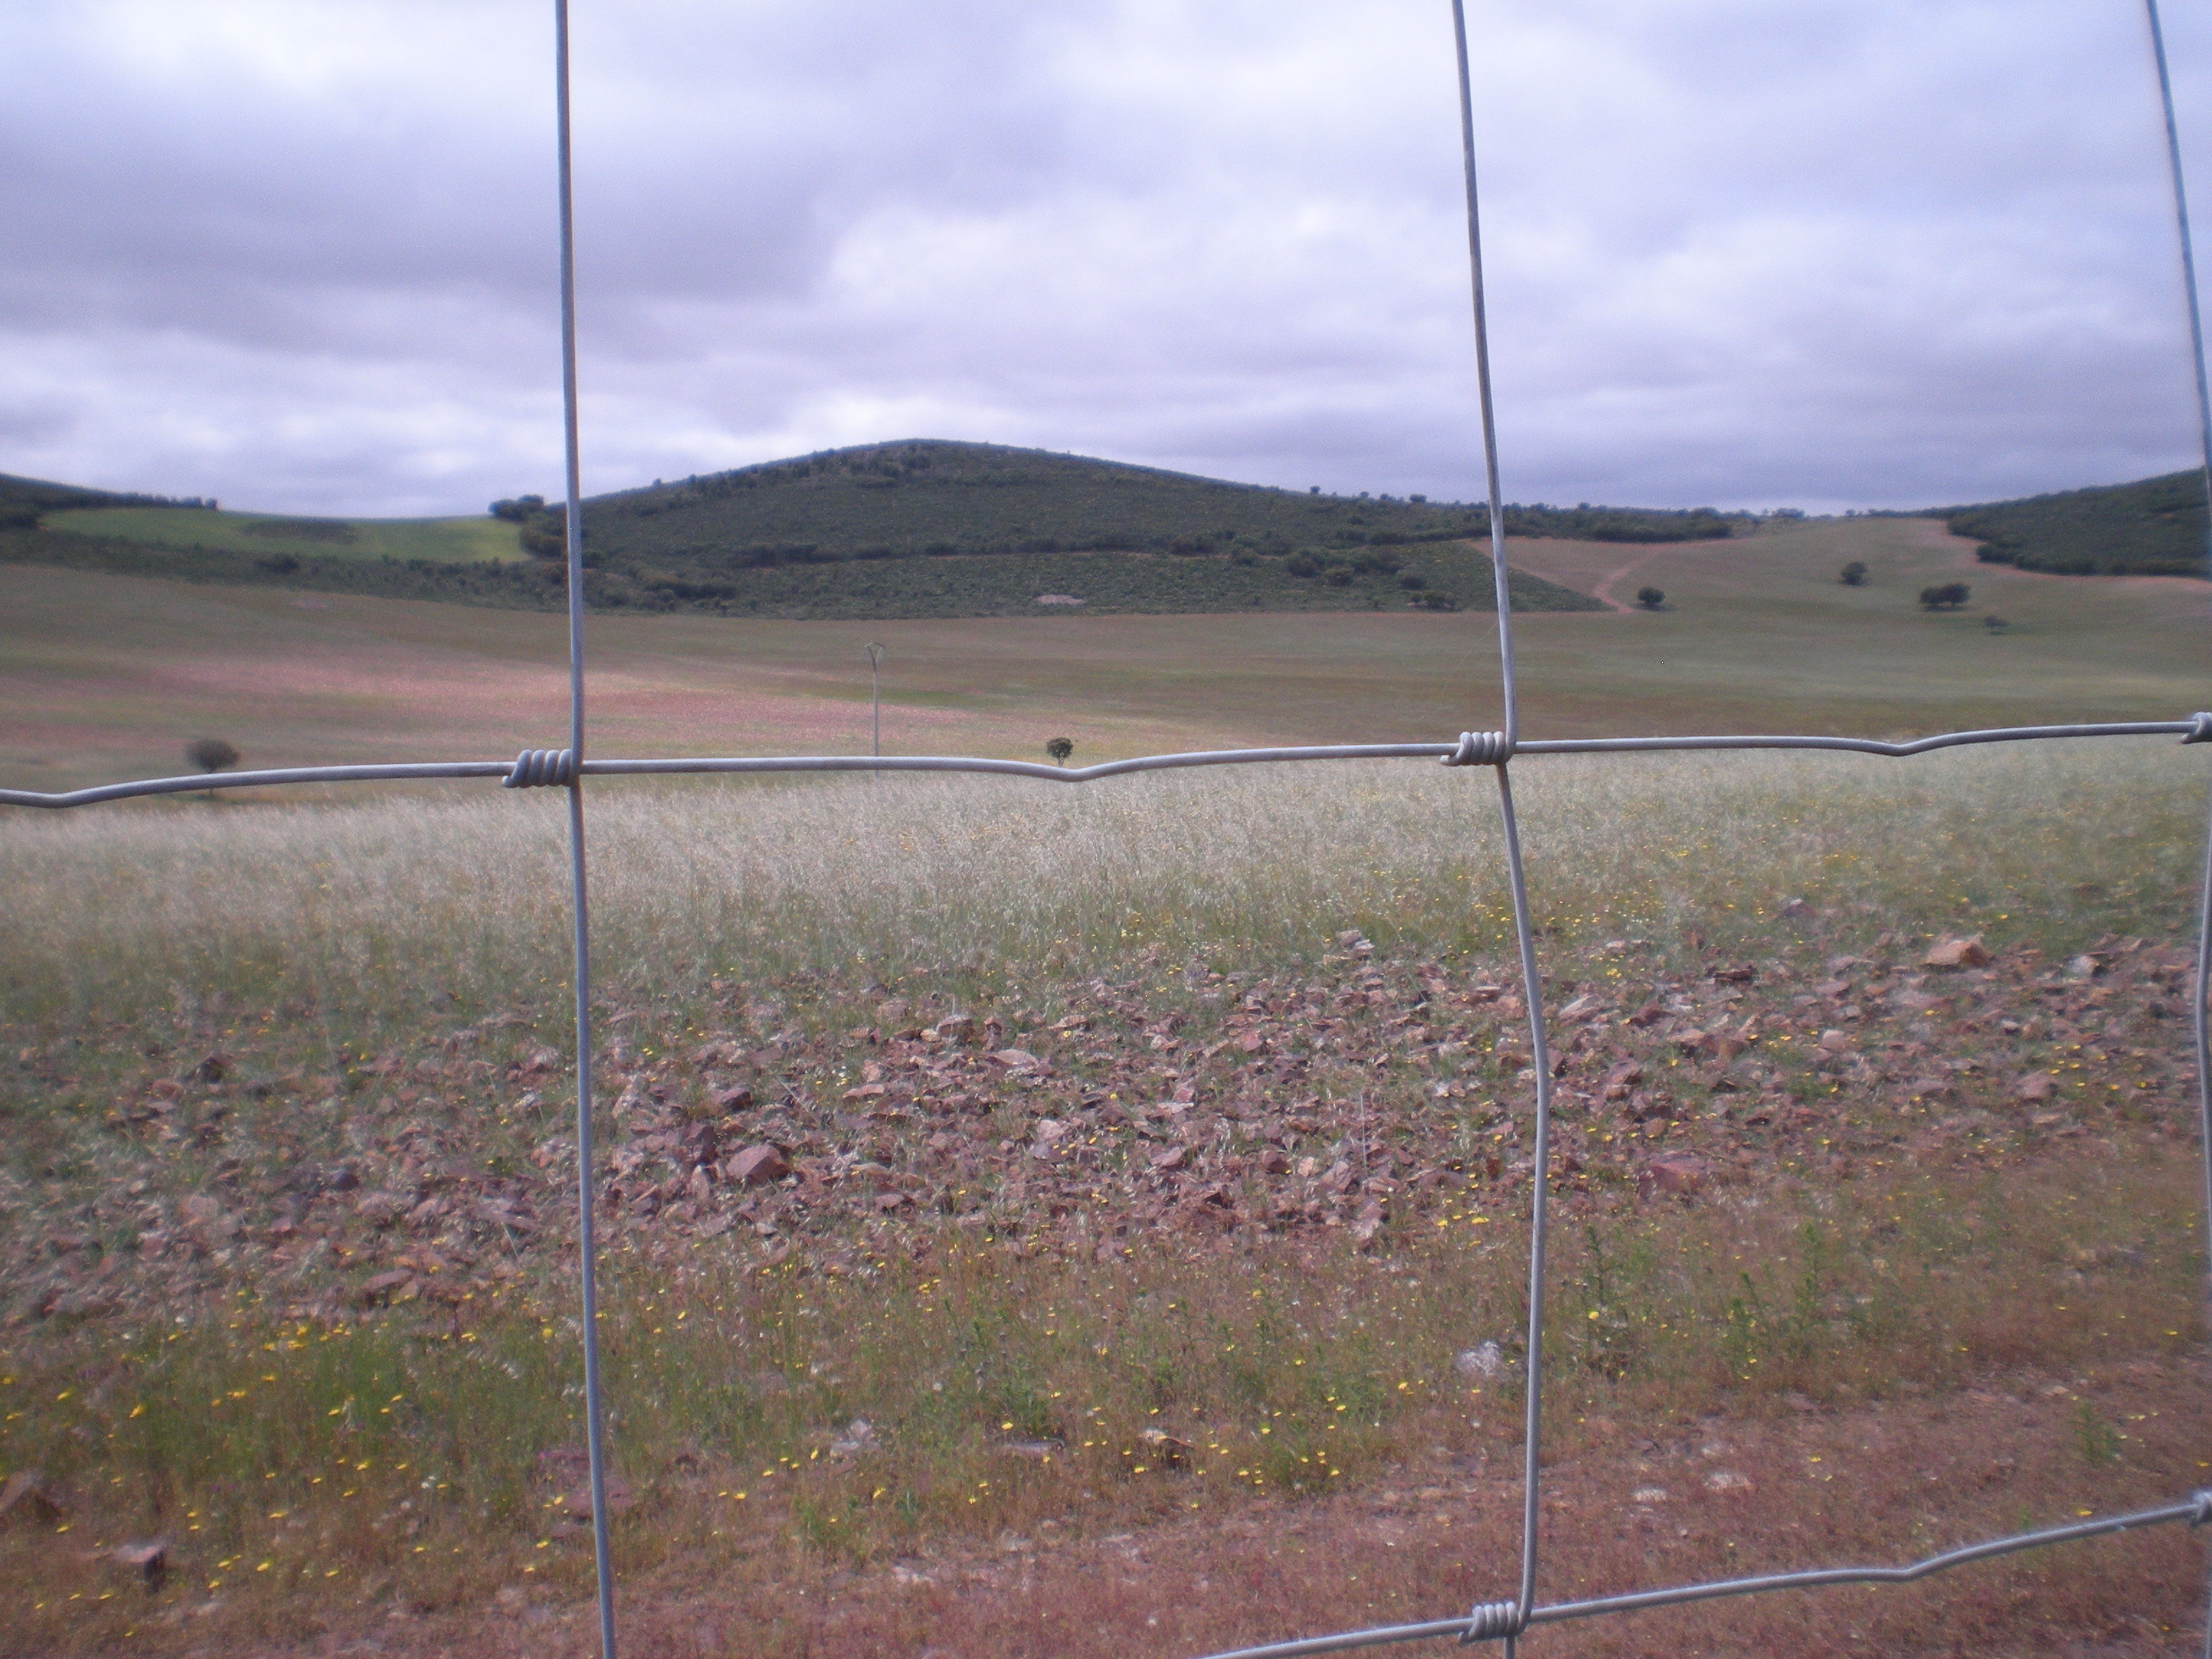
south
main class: Grassland
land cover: Spontaneously vegetated surfaces
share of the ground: 25 - 50 %
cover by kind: unconsolidated bare surface 75 %, herbaceous plants 25 %
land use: Fallow land
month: May
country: ES
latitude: 38.8344
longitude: -3.5031
